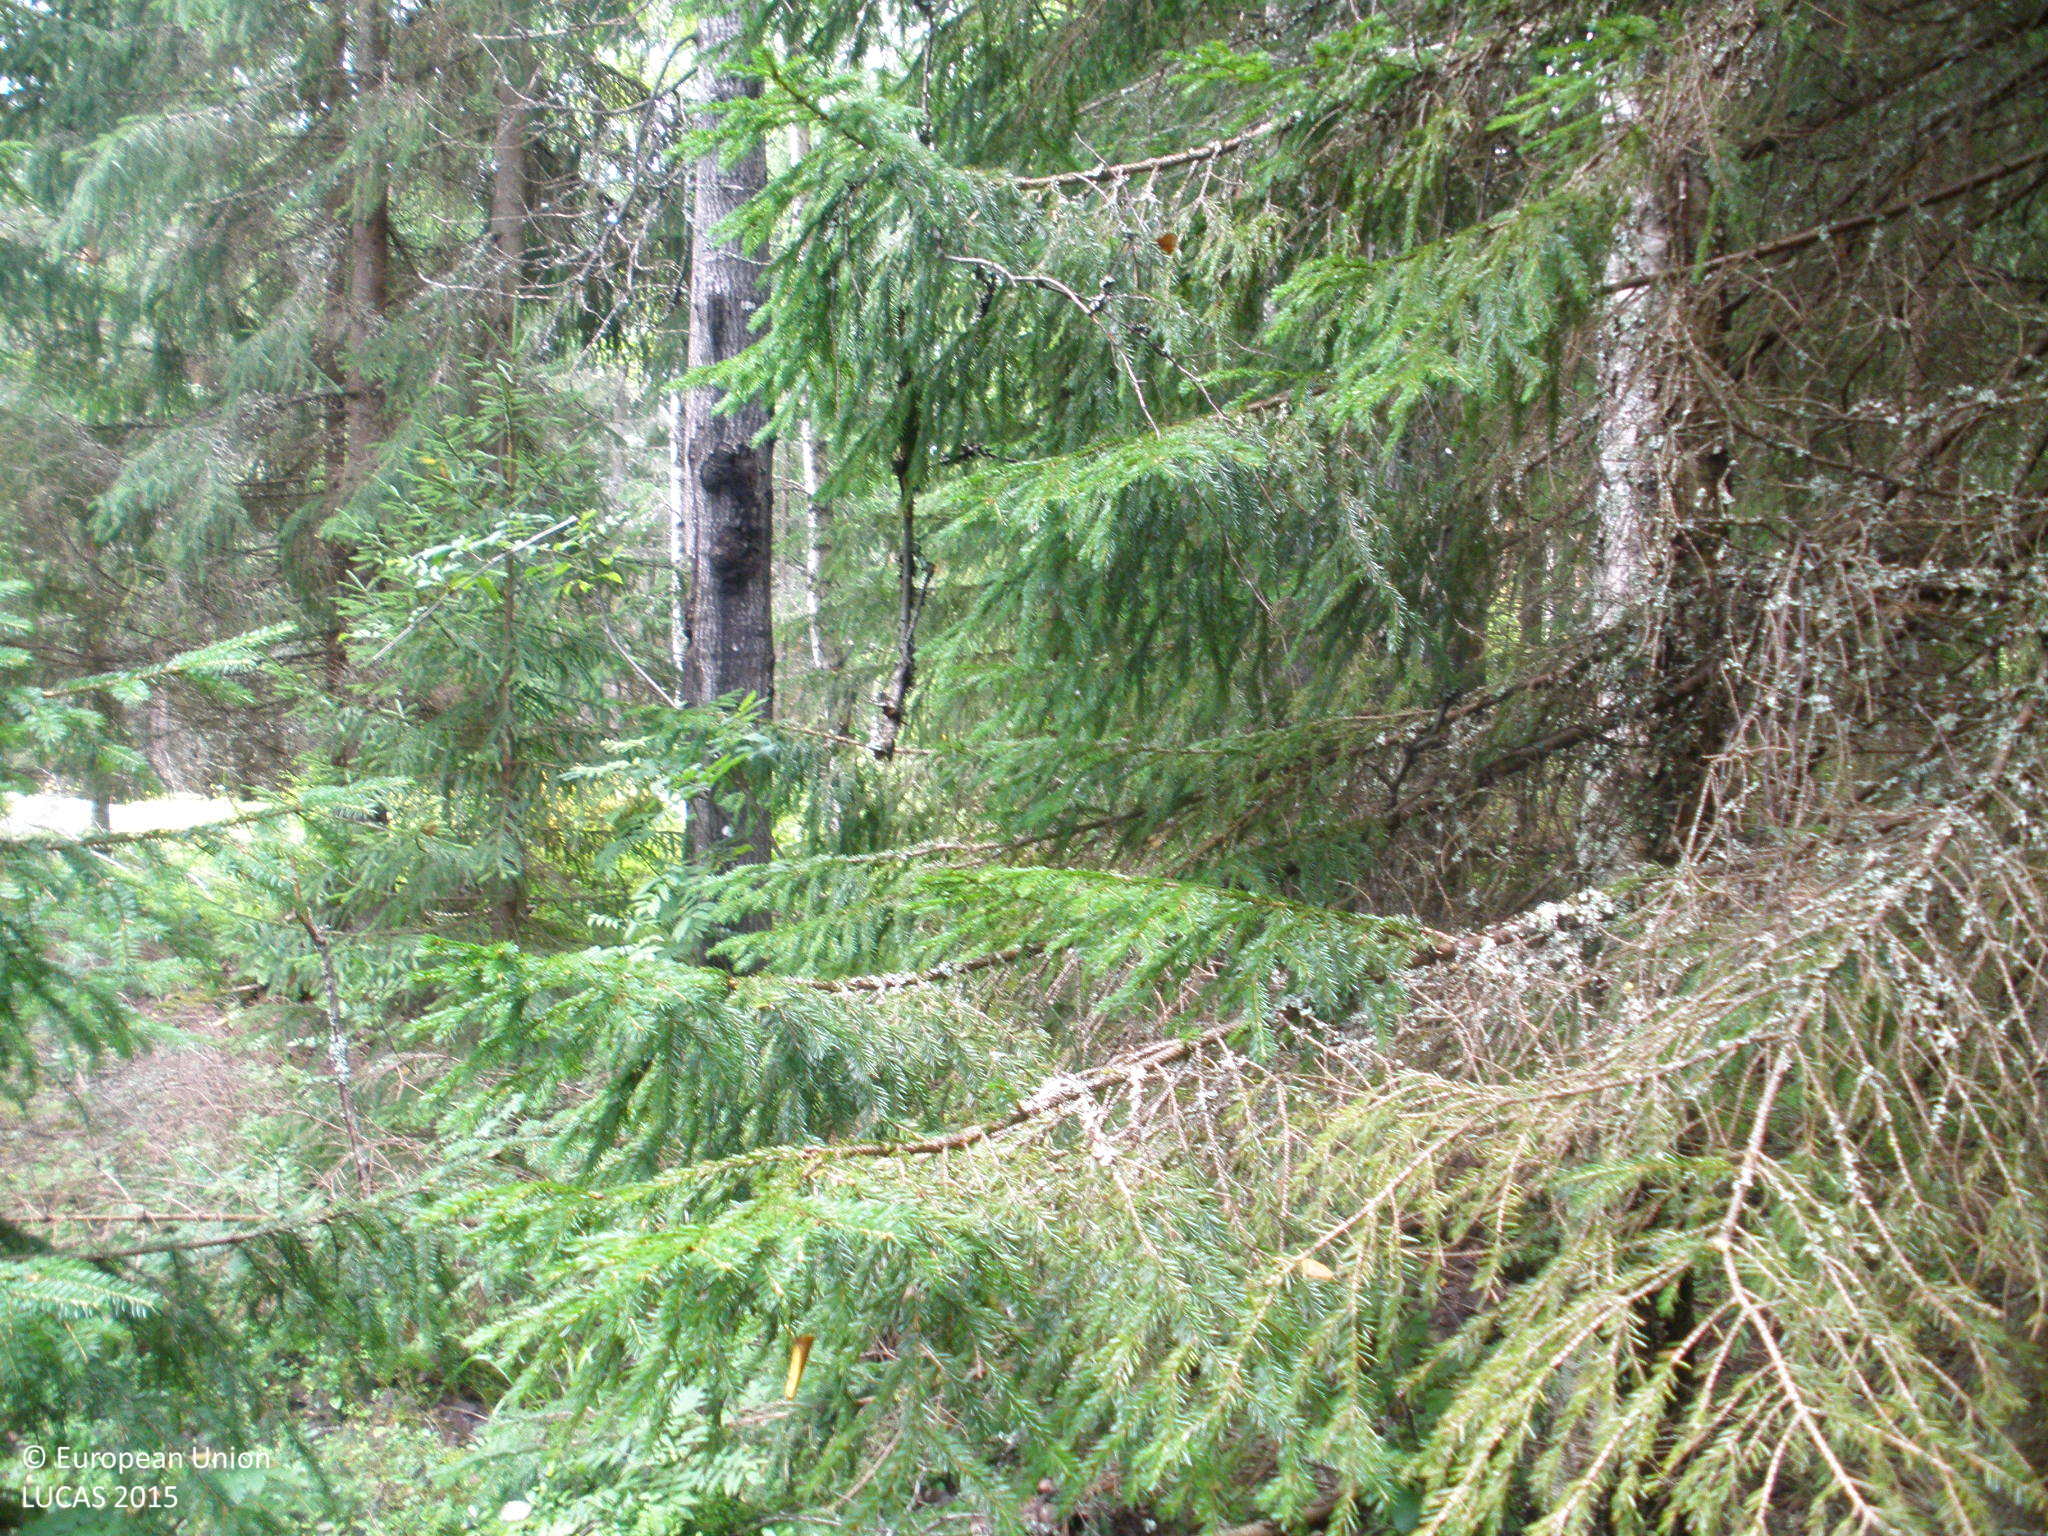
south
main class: Woodland
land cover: Spruce dominated coniferous woodland
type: boreal forest
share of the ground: > 75 %
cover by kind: coniferous forest trees 90 %, herbaceous plants 5 %, lichens and mosses 5 %
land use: Forestry
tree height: > 5 m
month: July
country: FI
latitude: 60.9475
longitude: 25.0495
